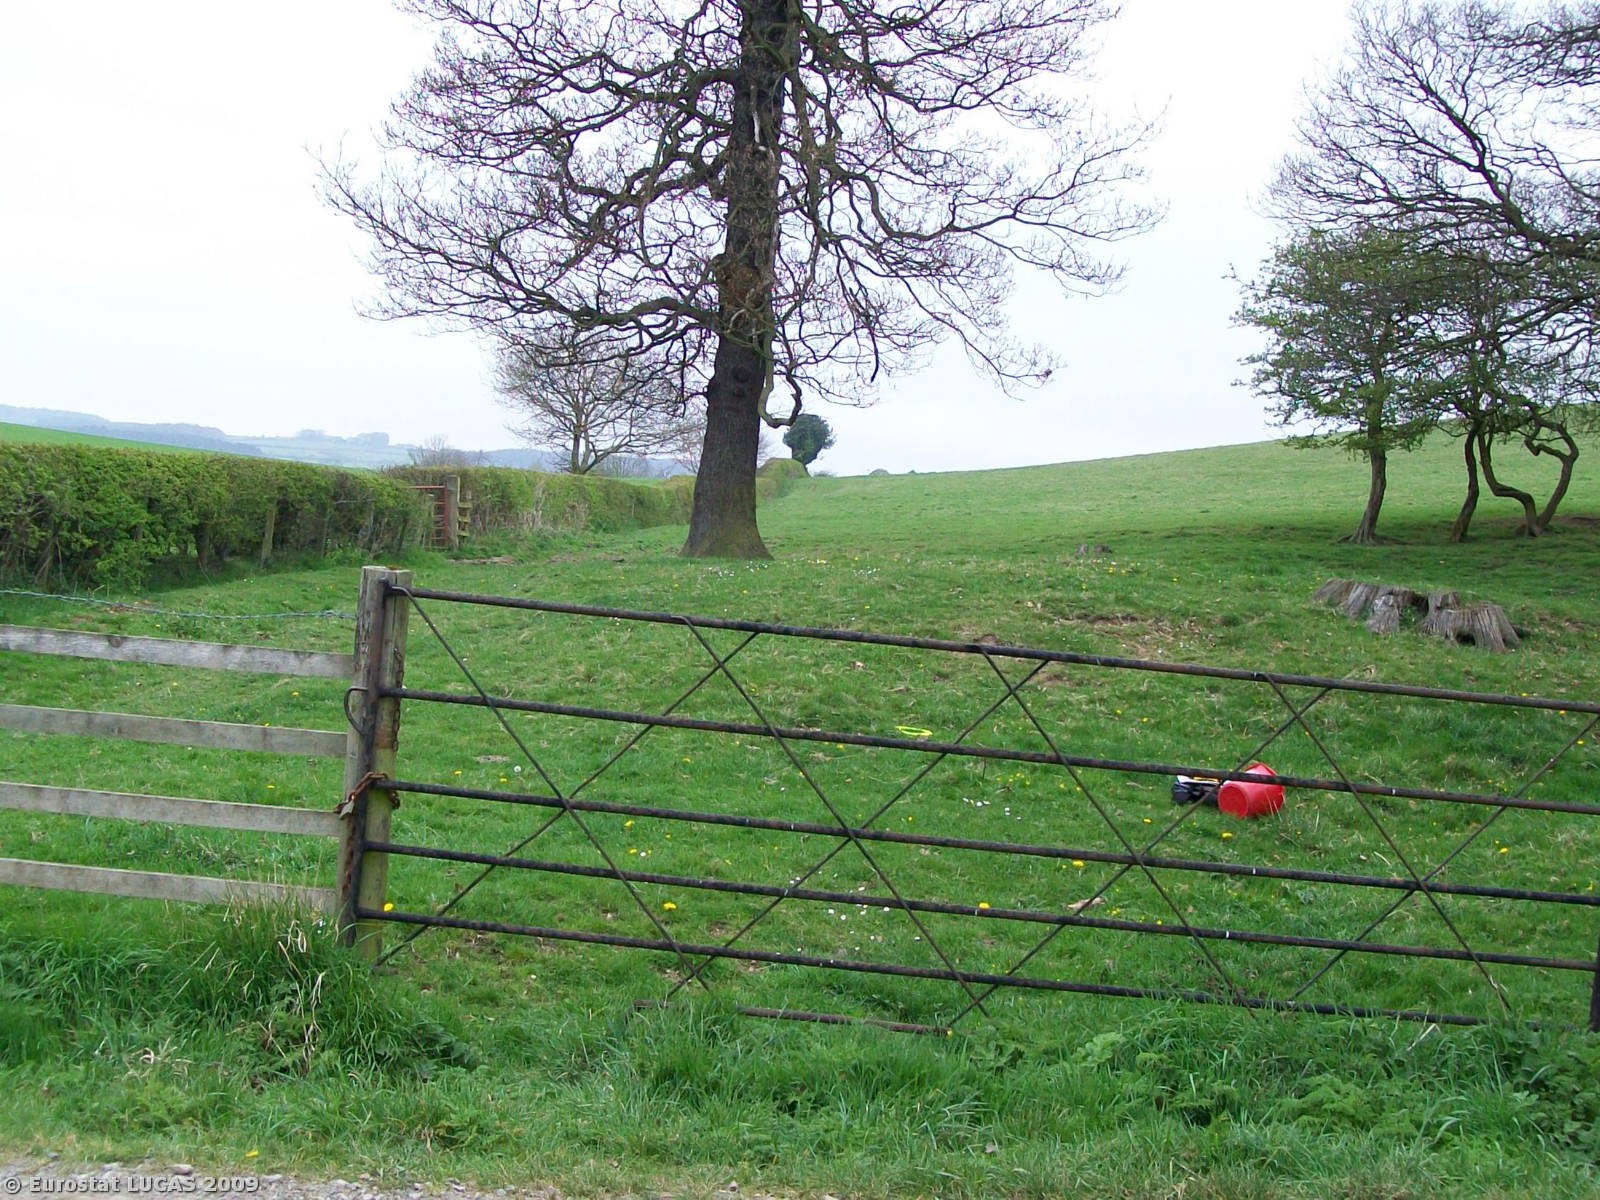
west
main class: Grassland
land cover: Grassland with sparse tree/shrub cover
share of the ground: 10 - 25 %
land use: Agriculture (excluding fallow land and kitchen gardens)
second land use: Community services
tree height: > 5 m
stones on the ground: < 10 %
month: April
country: GB
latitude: 54.8015
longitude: -1.6391
